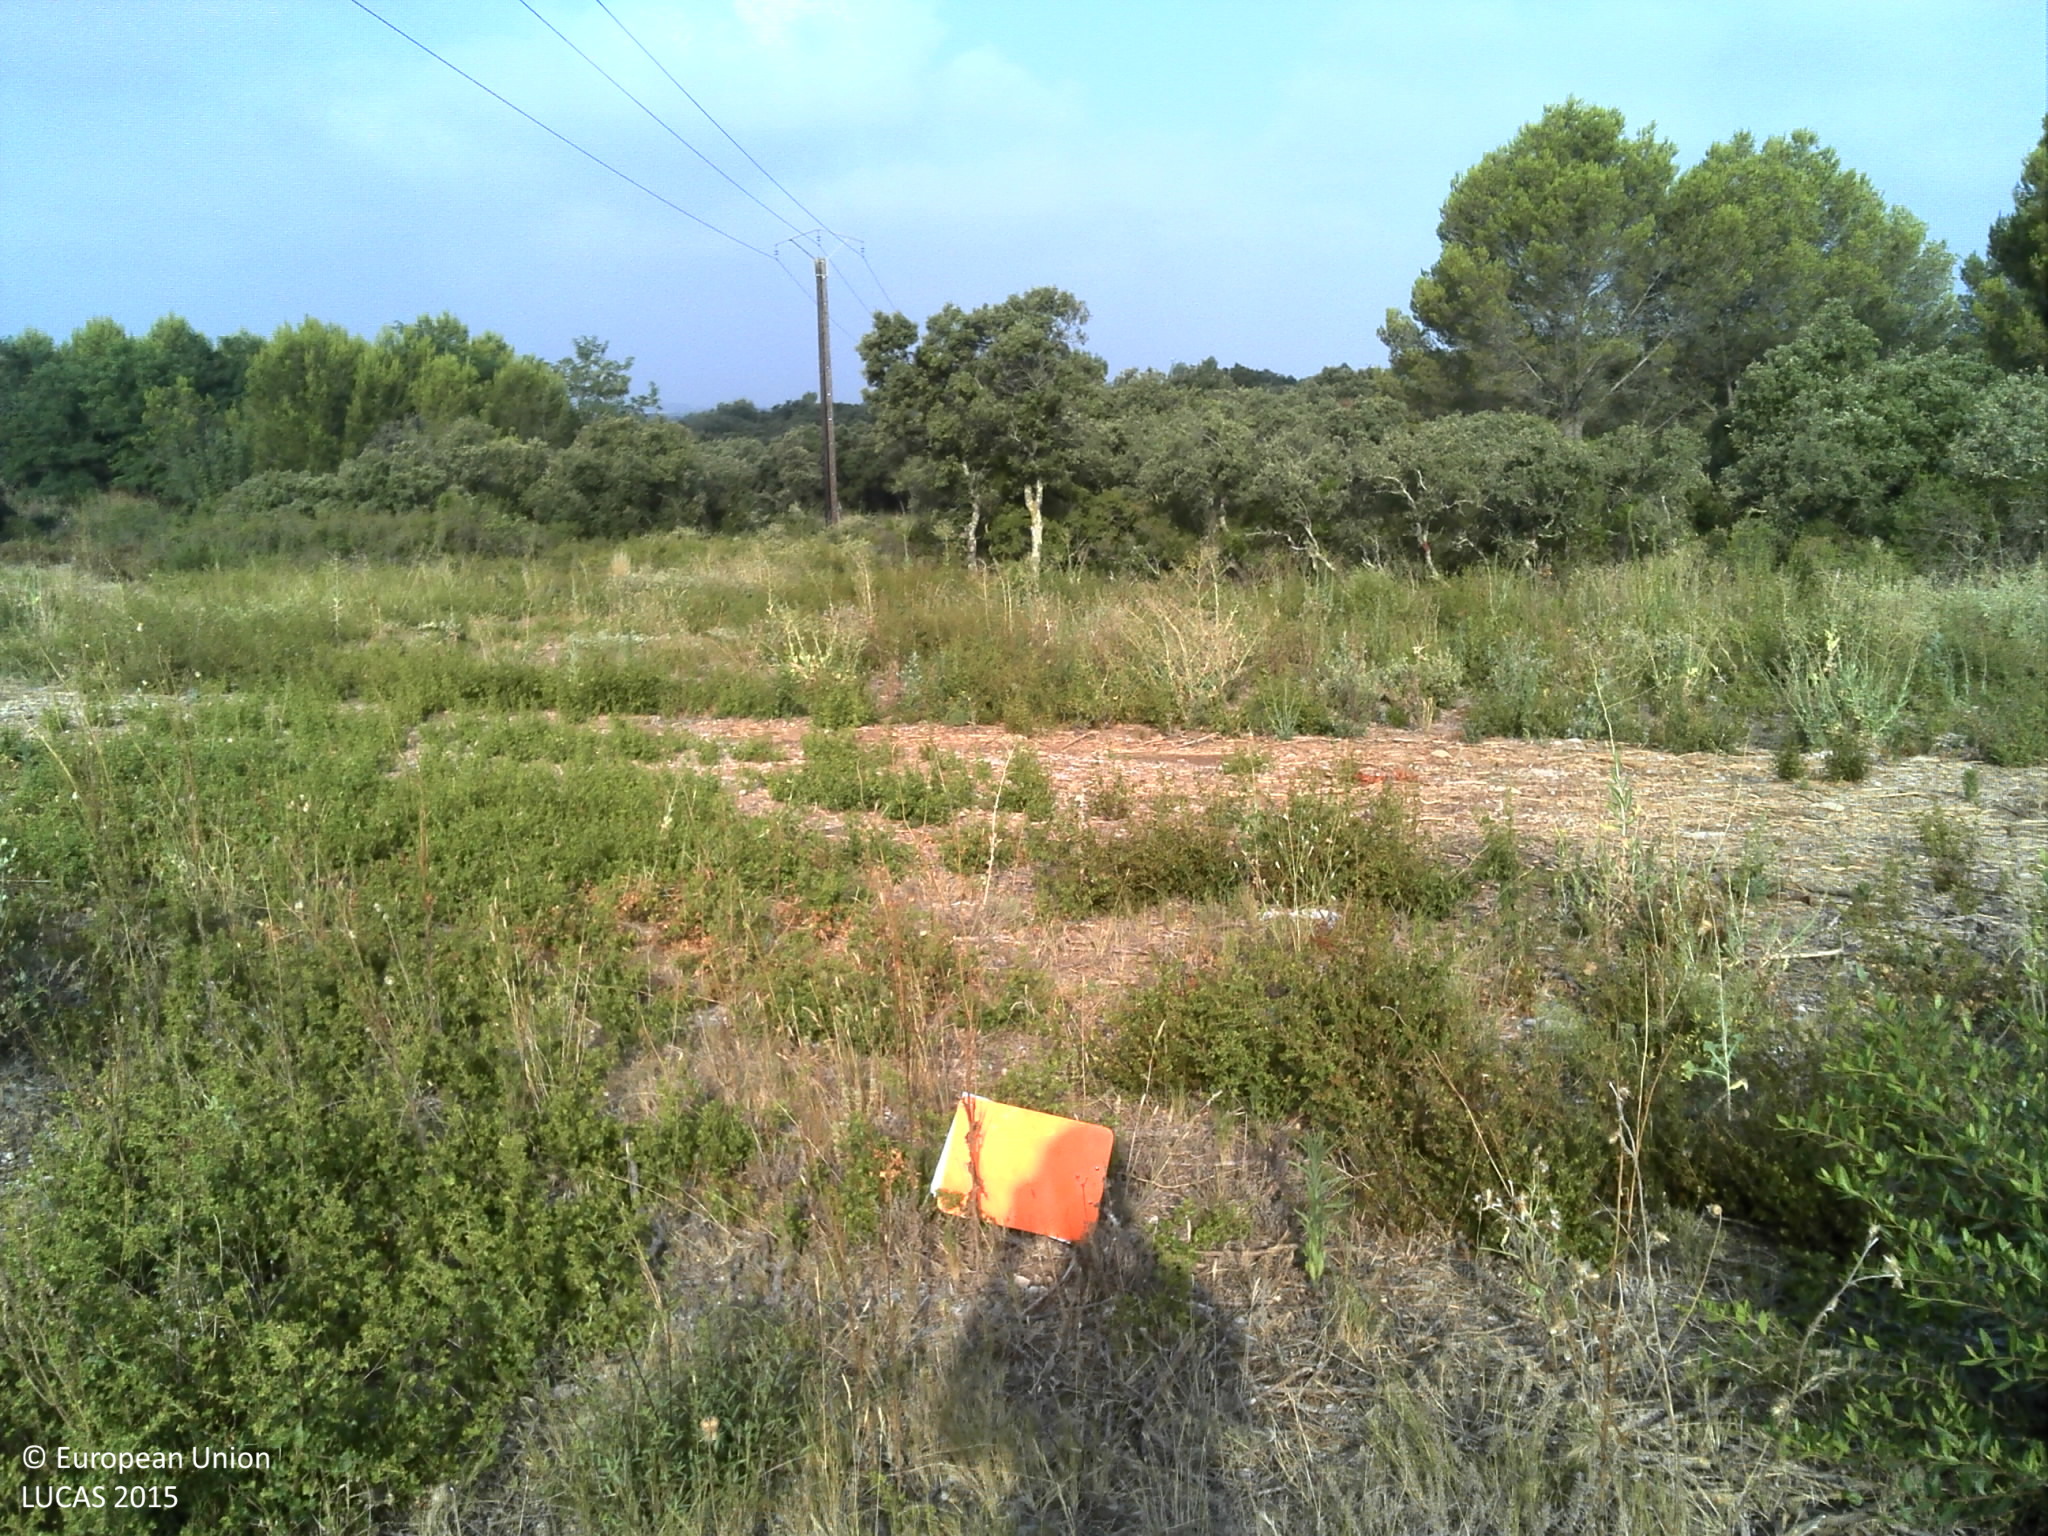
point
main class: Shrubland
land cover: Shrubland with sparse tree cover
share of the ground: > 75 %
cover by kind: shrubs 65 %, herbaceous plants 10 %, consolidated bare surface 10 %, unconsolidated bare surface 10 %, broadleaved forest trees 5 %
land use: Semi-natural and natural areas not in use
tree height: < 5 m
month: July
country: FR
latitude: 43.6702
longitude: 3.9939
